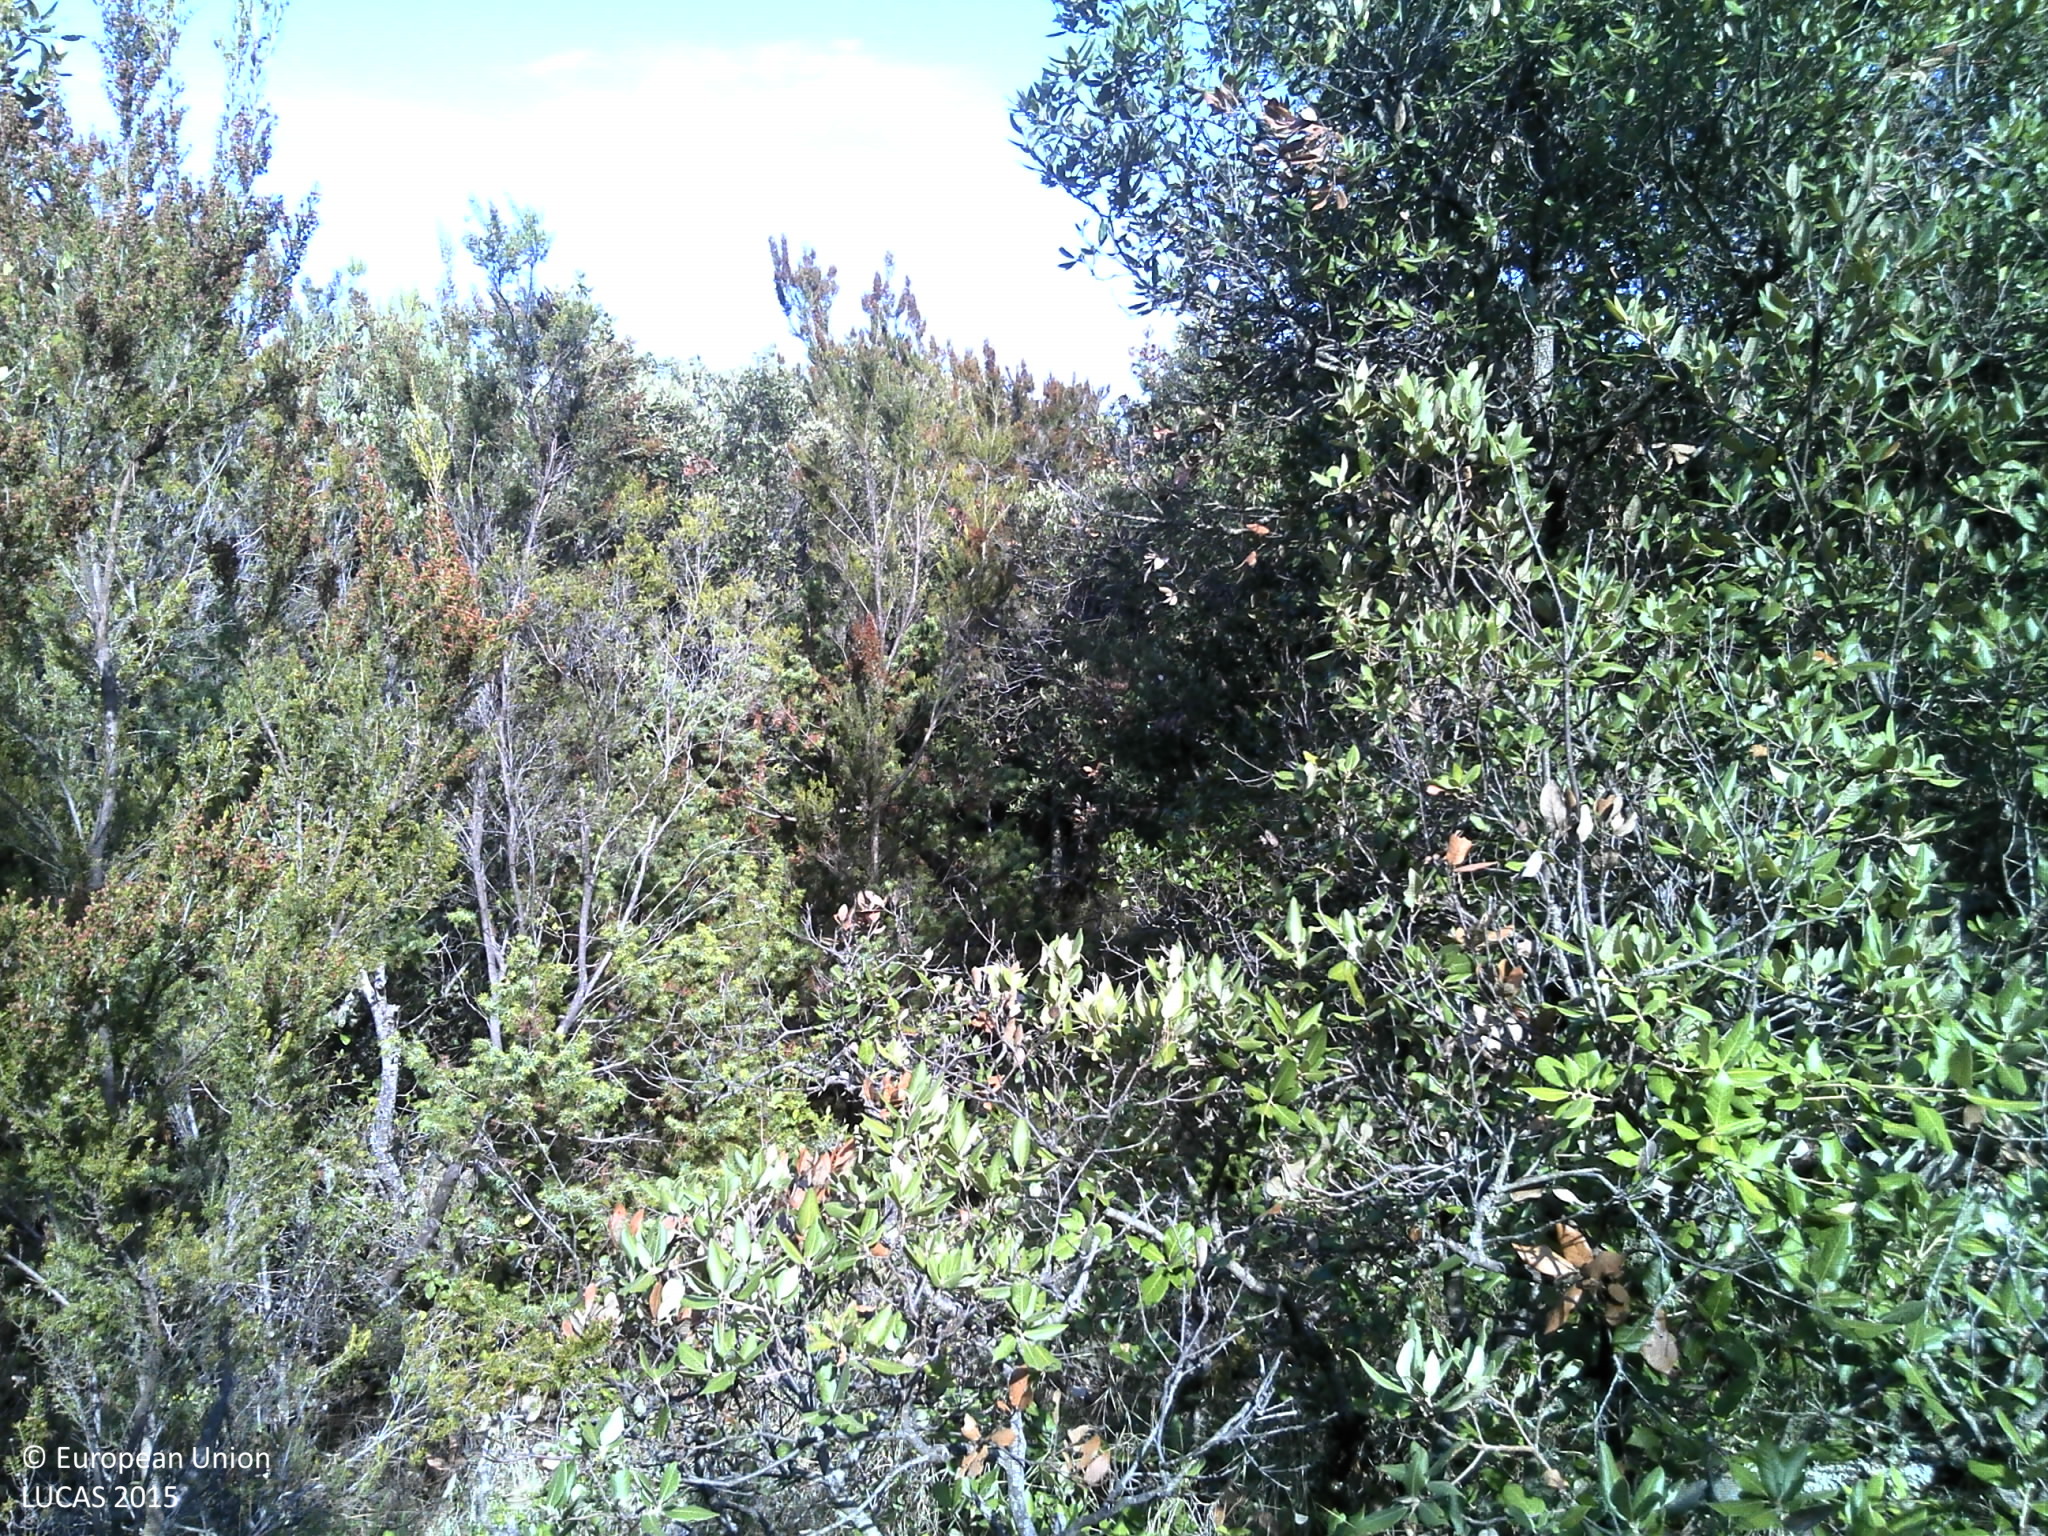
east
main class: Shrubland
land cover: Shrubland with sparse tree cover
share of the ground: > 75 %
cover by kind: shrubs 75 %, broadleaved forest trees 5 %, herbaceous plants 5 %, lichens and mosses 5 %, consolidated bare surface 5 %, unconsolidated bare surface 5 %
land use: Semi-natural and natural areas not in use
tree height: < 5 m
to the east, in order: Shrubland with sparse tree cover; Dry stone walls; Grassland with sparse tree/shrub cover; Dry stone walls; Grassland with sparse tree/shrub cover; Dry stone walls; Grassland with sparse tree/shrub cover; Dry stone walls; Grassland with sparse tree/shrub cover; Dry stone walls; Shrubland with sparse tree cover; Dry stone walls; Shrubland with sparse tree cover; Dry stone walls; Shrubland with sparse tree cover; Dry stone walls; Shrubland with sparse tree cover; Dry stone walls; Shrubland with sparse tree cover; Dry stone walls; Grassland with sparse tree/shrub cover
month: August
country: HR
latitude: 43.1390
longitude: 16.9609
